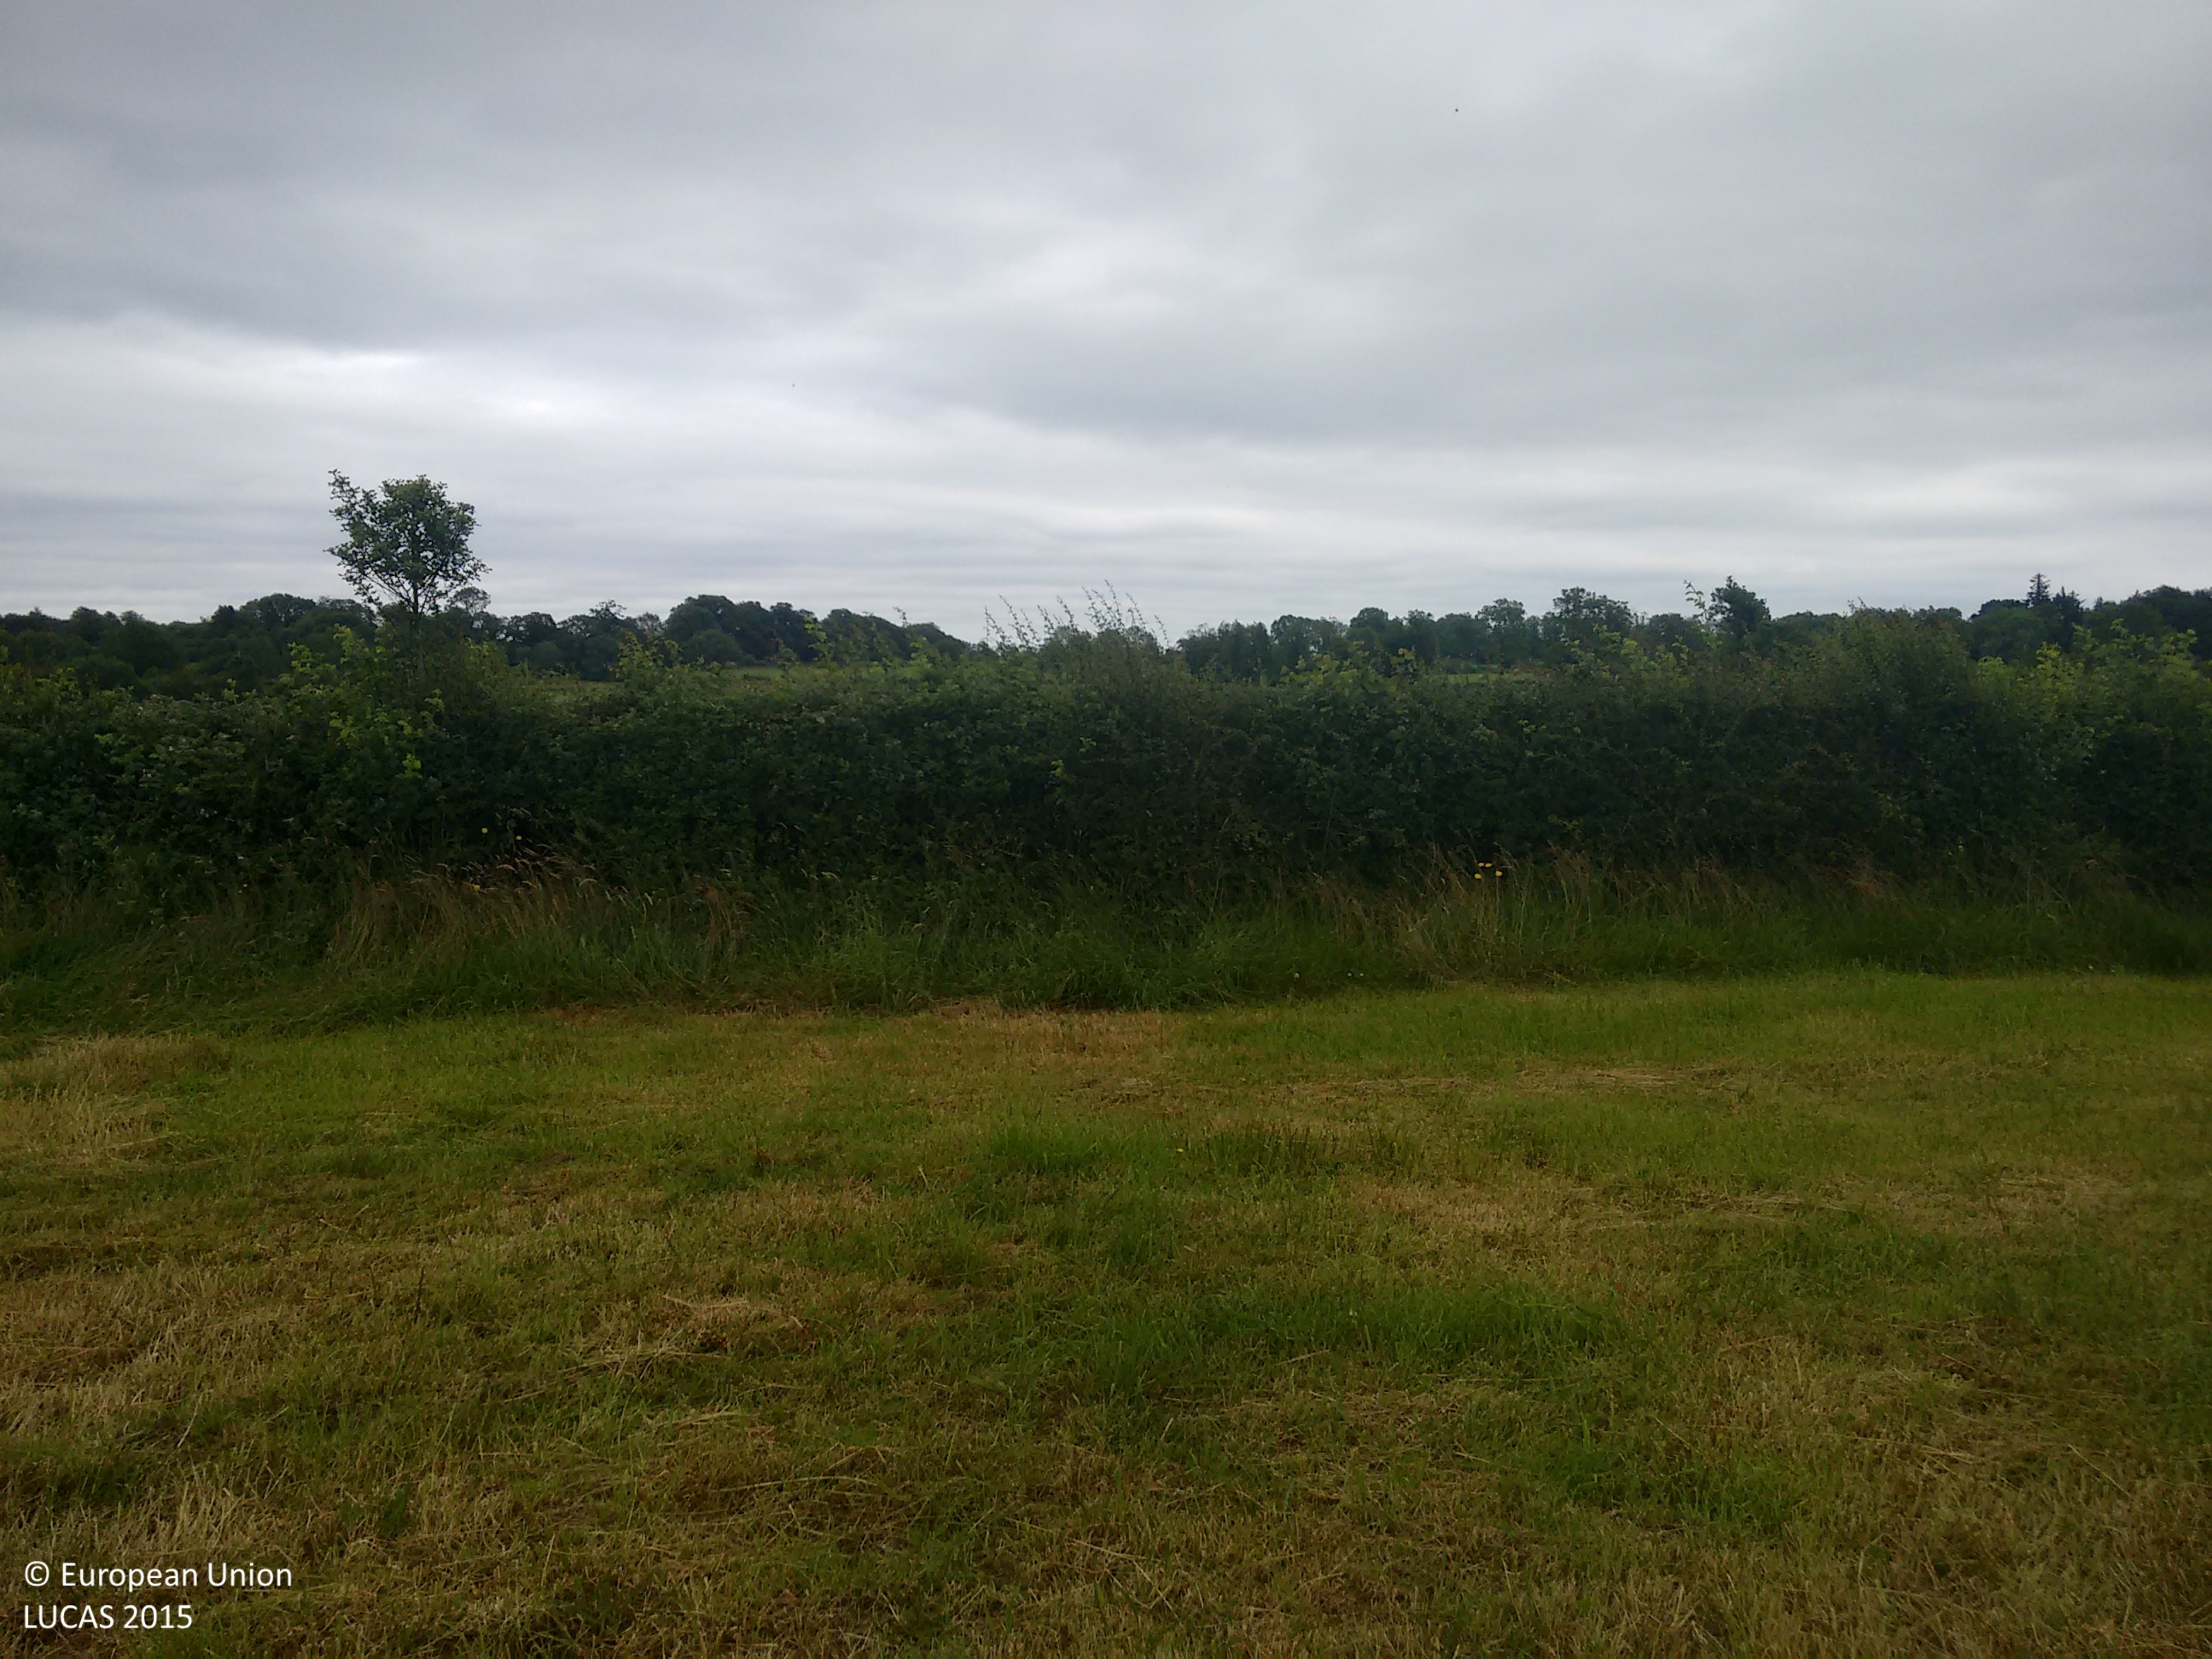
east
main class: Grassland
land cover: Grassland without tree/shrub cover
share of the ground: > 75 %
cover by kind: herbaceous plants 100 %
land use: Agriculture (excluding fallow land and kitchen gardens)
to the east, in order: Grassland without tree/shrub cover; Abandoned hedges; Grassland without tree/shrub cover; Fences; Grass margins; Rivers and streams; Grass margins; Fences; Grassland without tree/shrub cover; Shruby margins; Fences; Grassland without tree/shrub cover
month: July
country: IE
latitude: 53.6621
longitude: -8.1117
